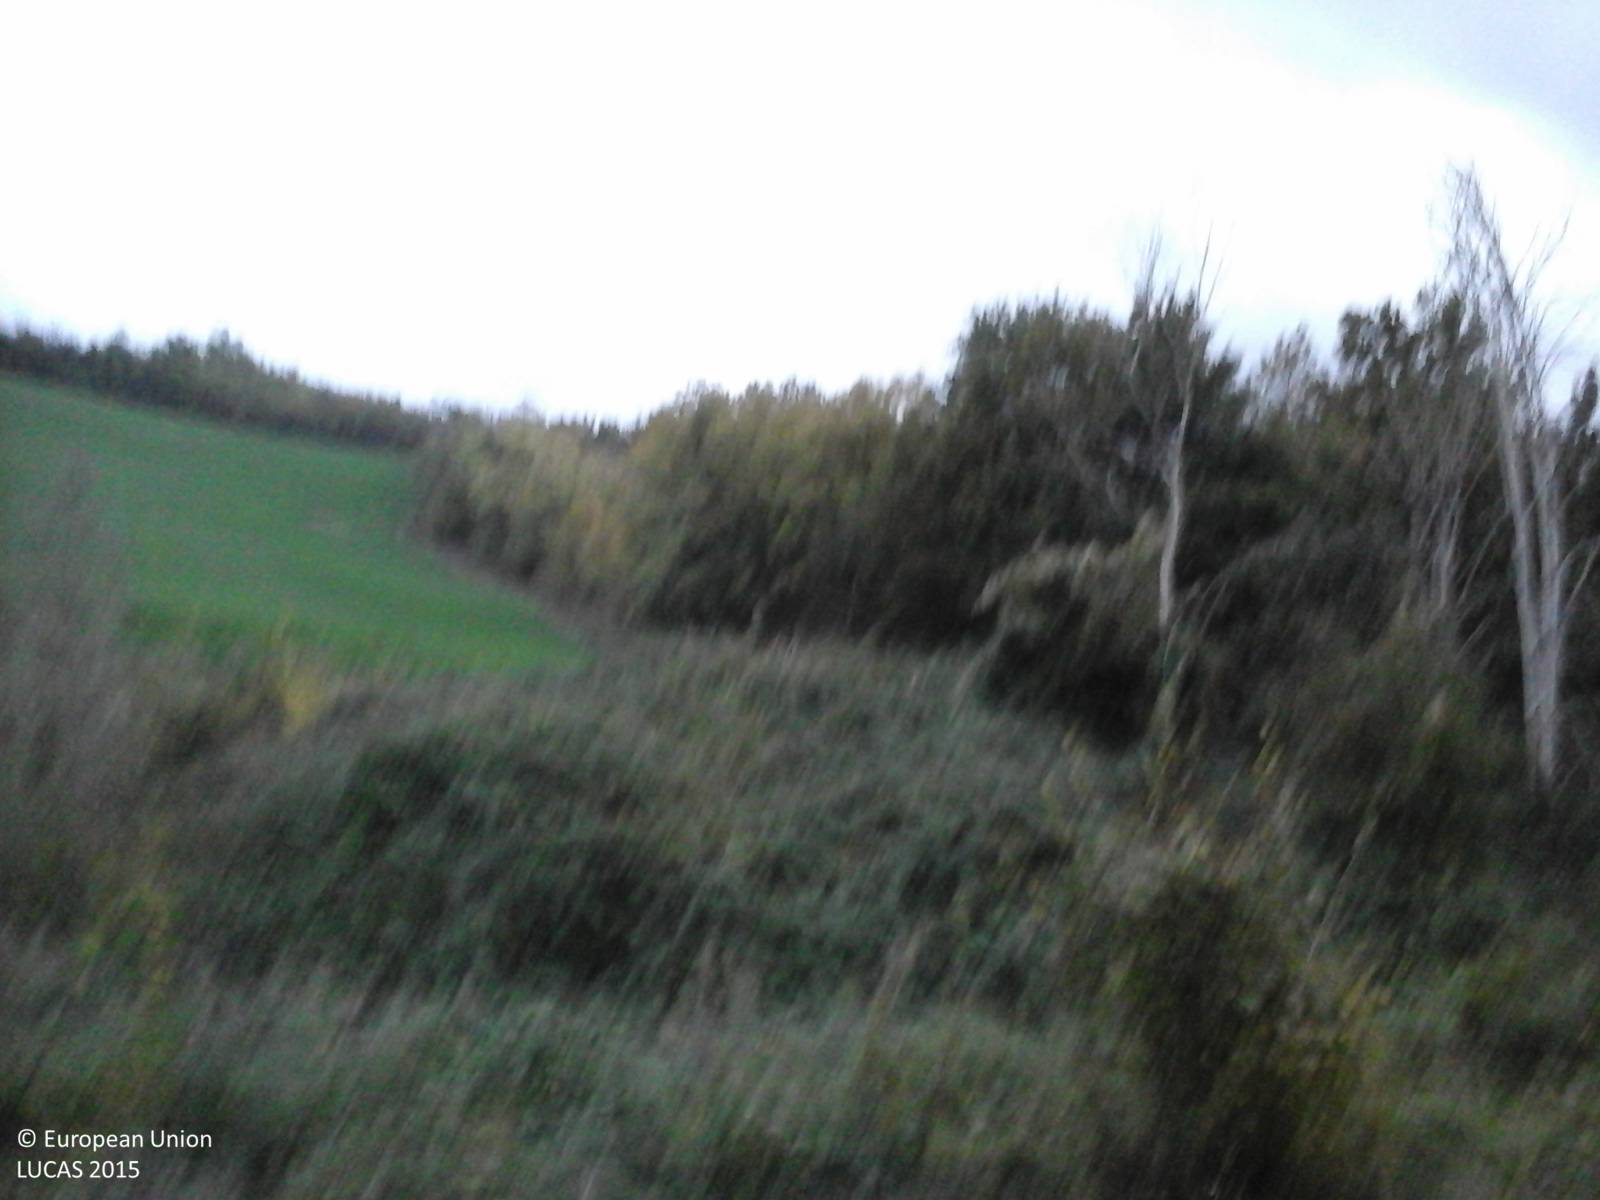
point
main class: Woodland
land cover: Broadleaved woodland
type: thermophilous deciduous forest
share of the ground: > 75 %
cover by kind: broadleaved forest trees 95 %, shrubs 5 %
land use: Forestry
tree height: > 5 m
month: October
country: IT
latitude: 42.6105
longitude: 12.2721
